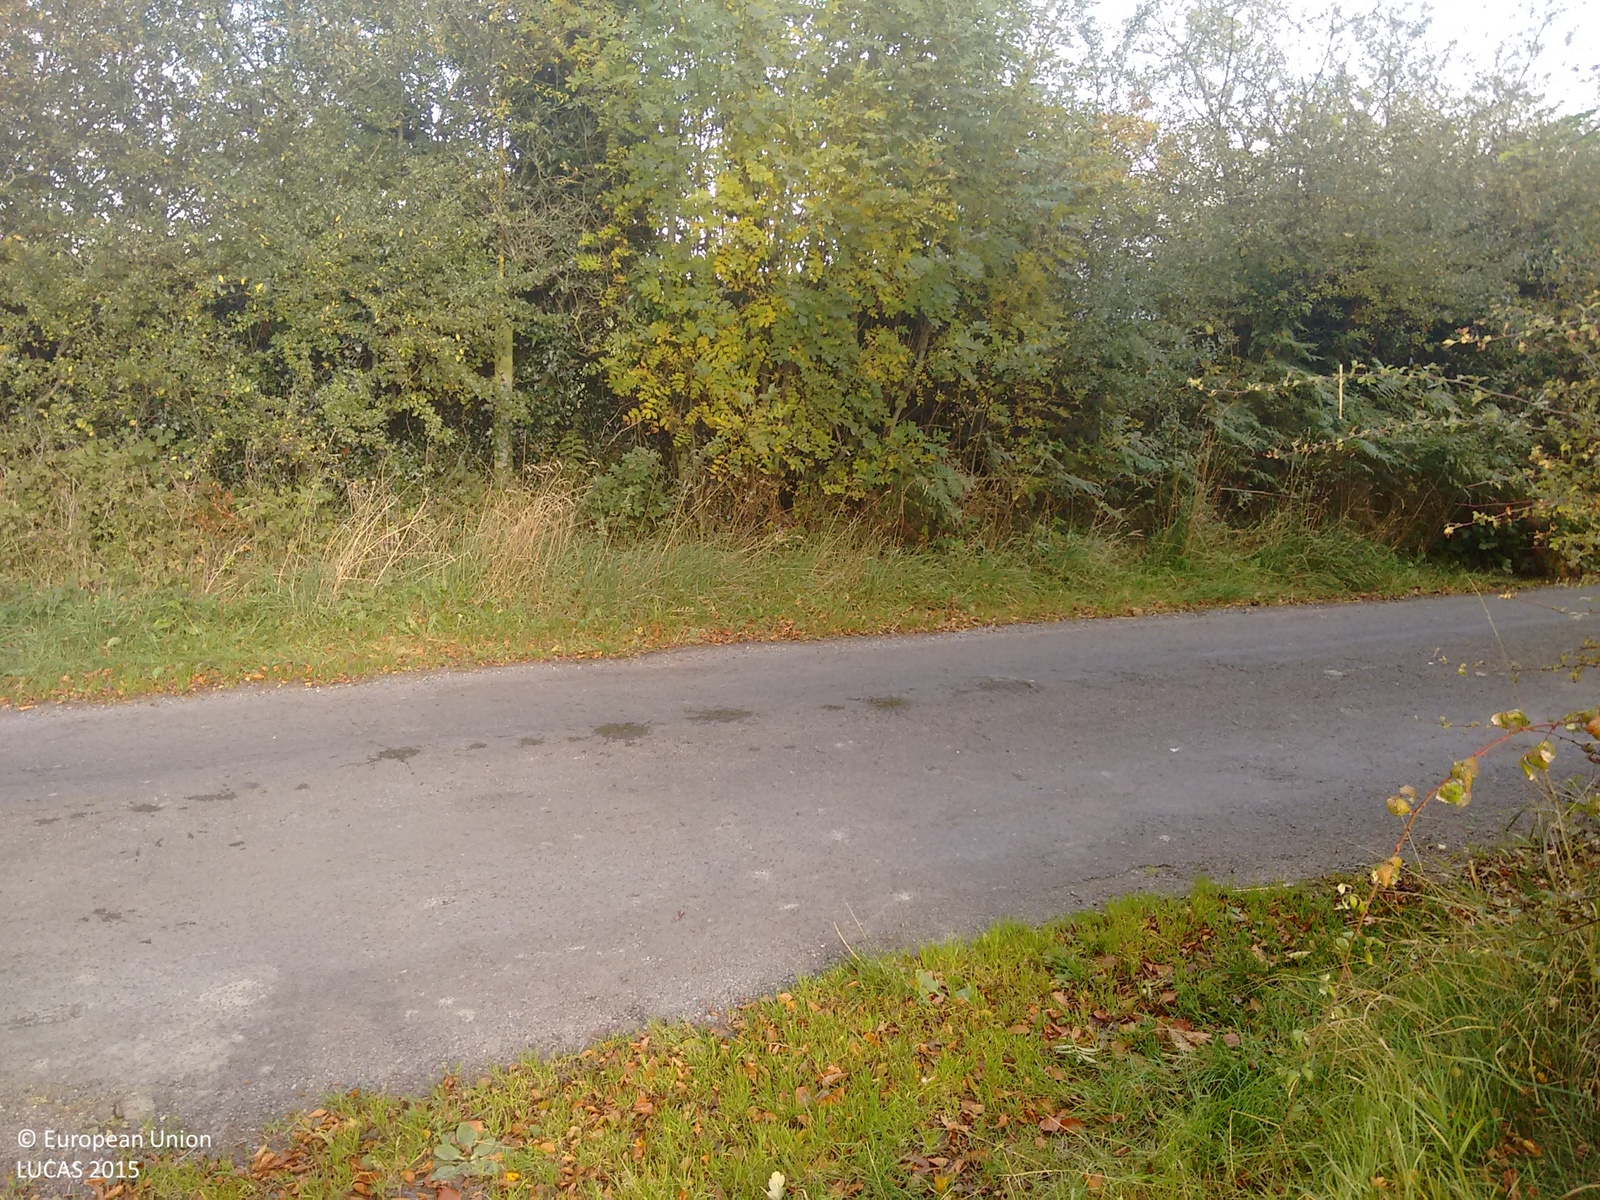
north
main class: Grassland
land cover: Grassland without tree/shrub cover
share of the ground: > 75 %
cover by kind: herbaceous plants 100 %
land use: Agriculture (excluding fallow land and kitchen gardens)
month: October
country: IE
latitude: 52.8343
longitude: -7.6036
